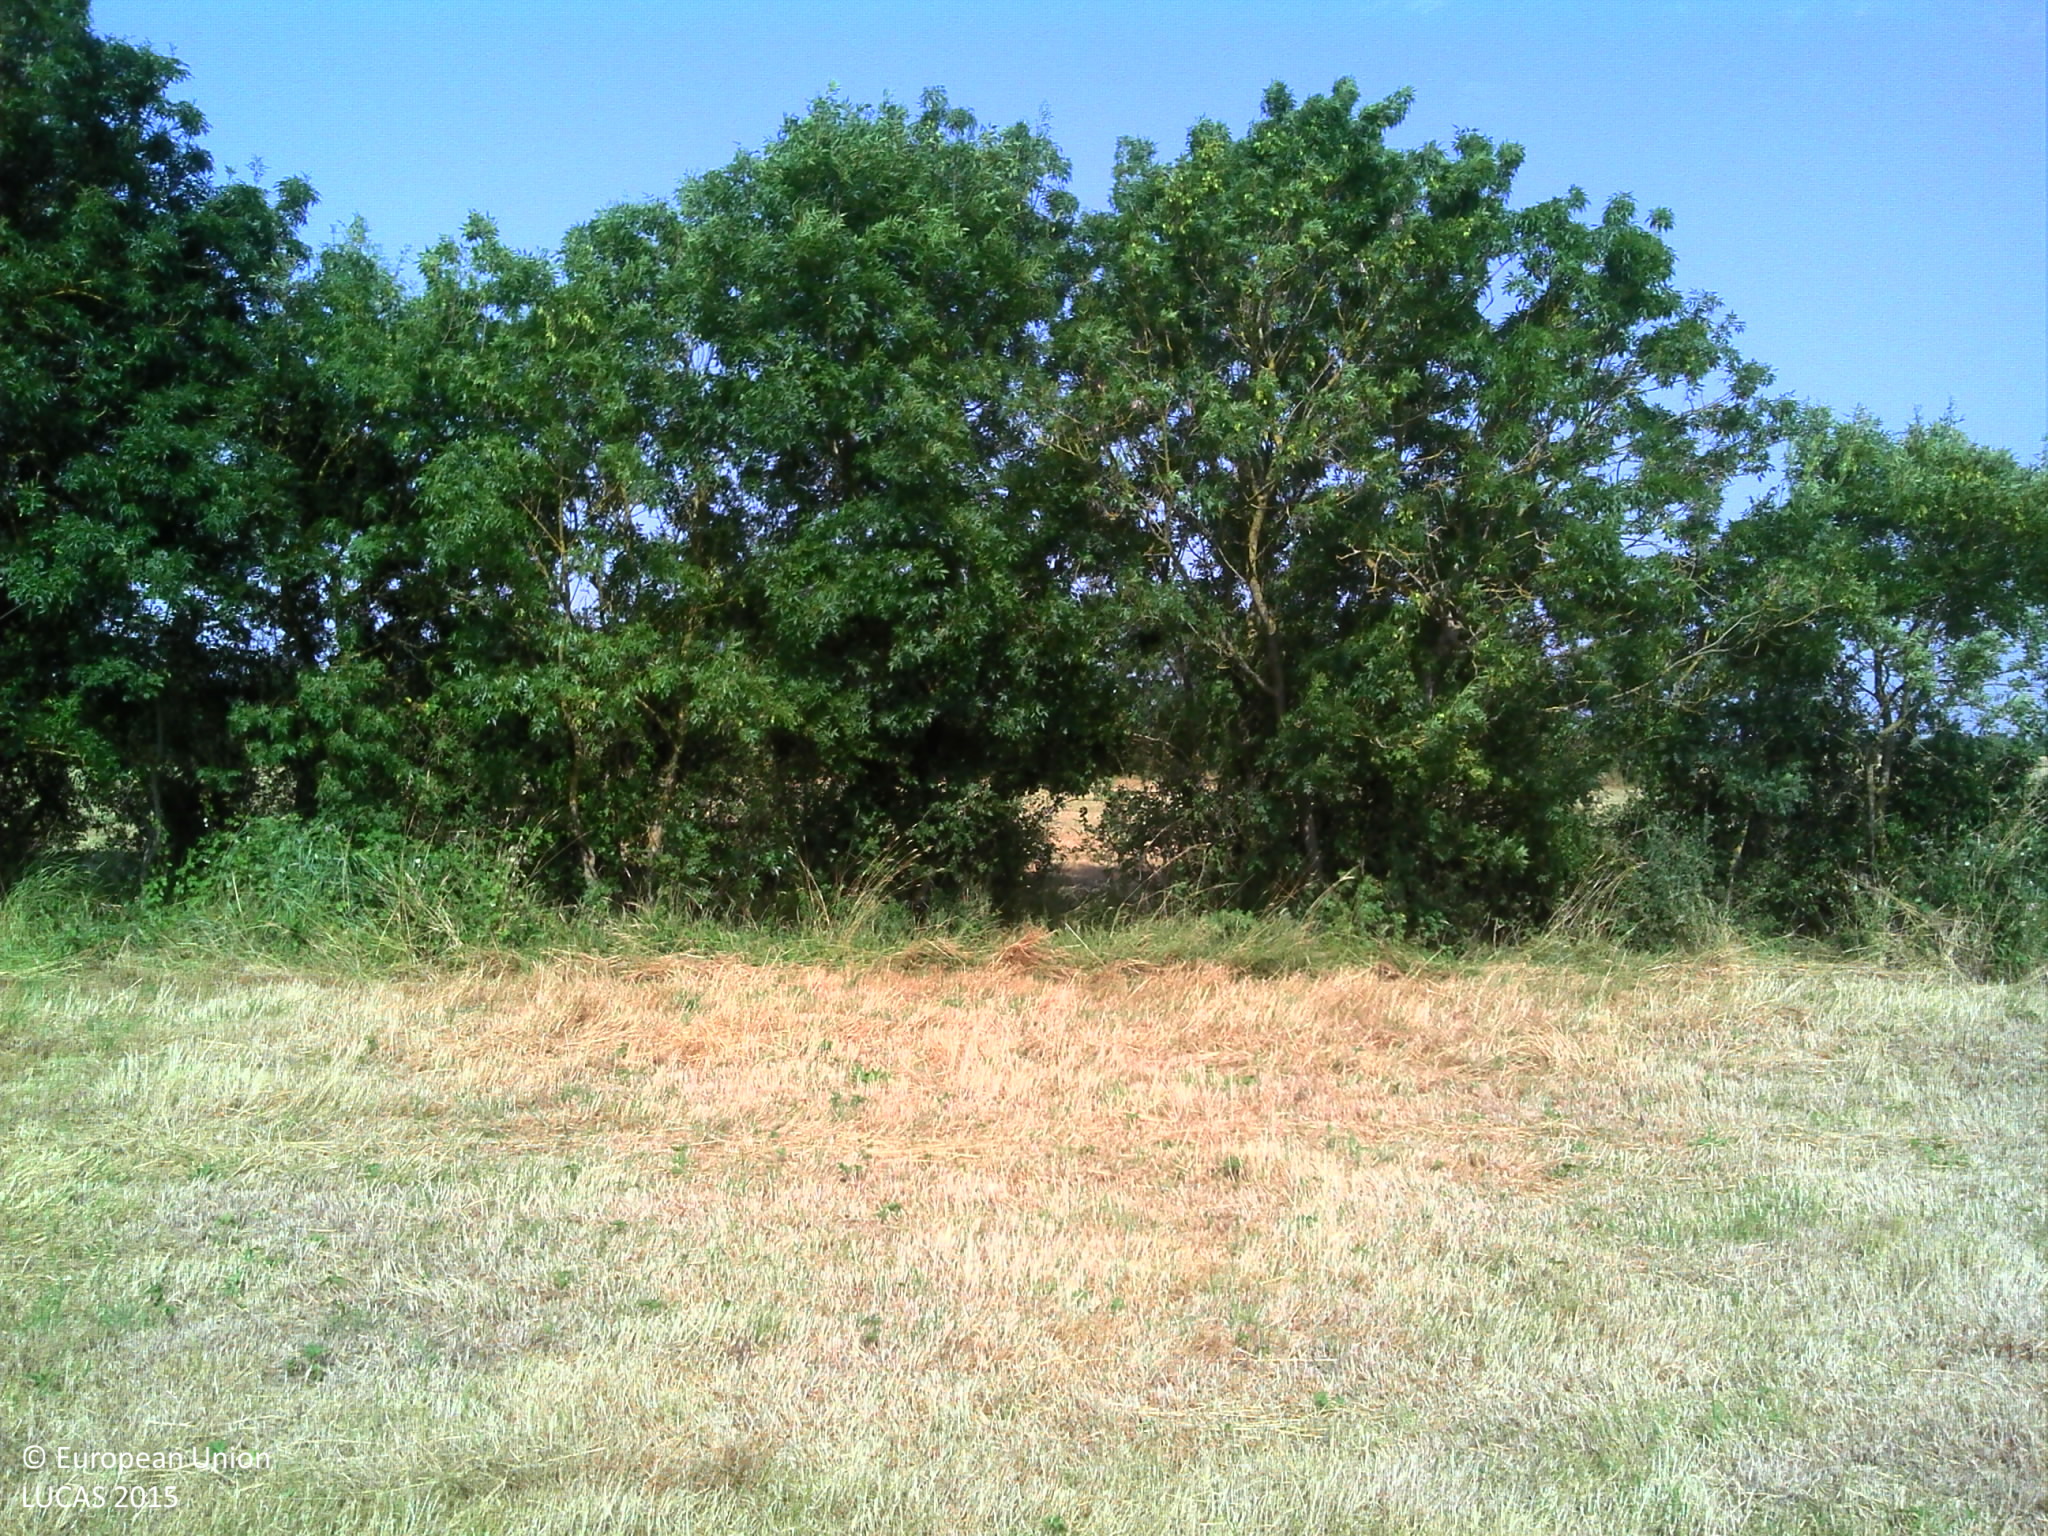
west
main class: Grassland
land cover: Grassland without tree/shrub cover
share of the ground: > 75 %
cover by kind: herbaceous plants 100 %
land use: Agriculture (excluding fallow land and kitchen gardens)
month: July
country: FR
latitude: 47.3114
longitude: -1.9934
